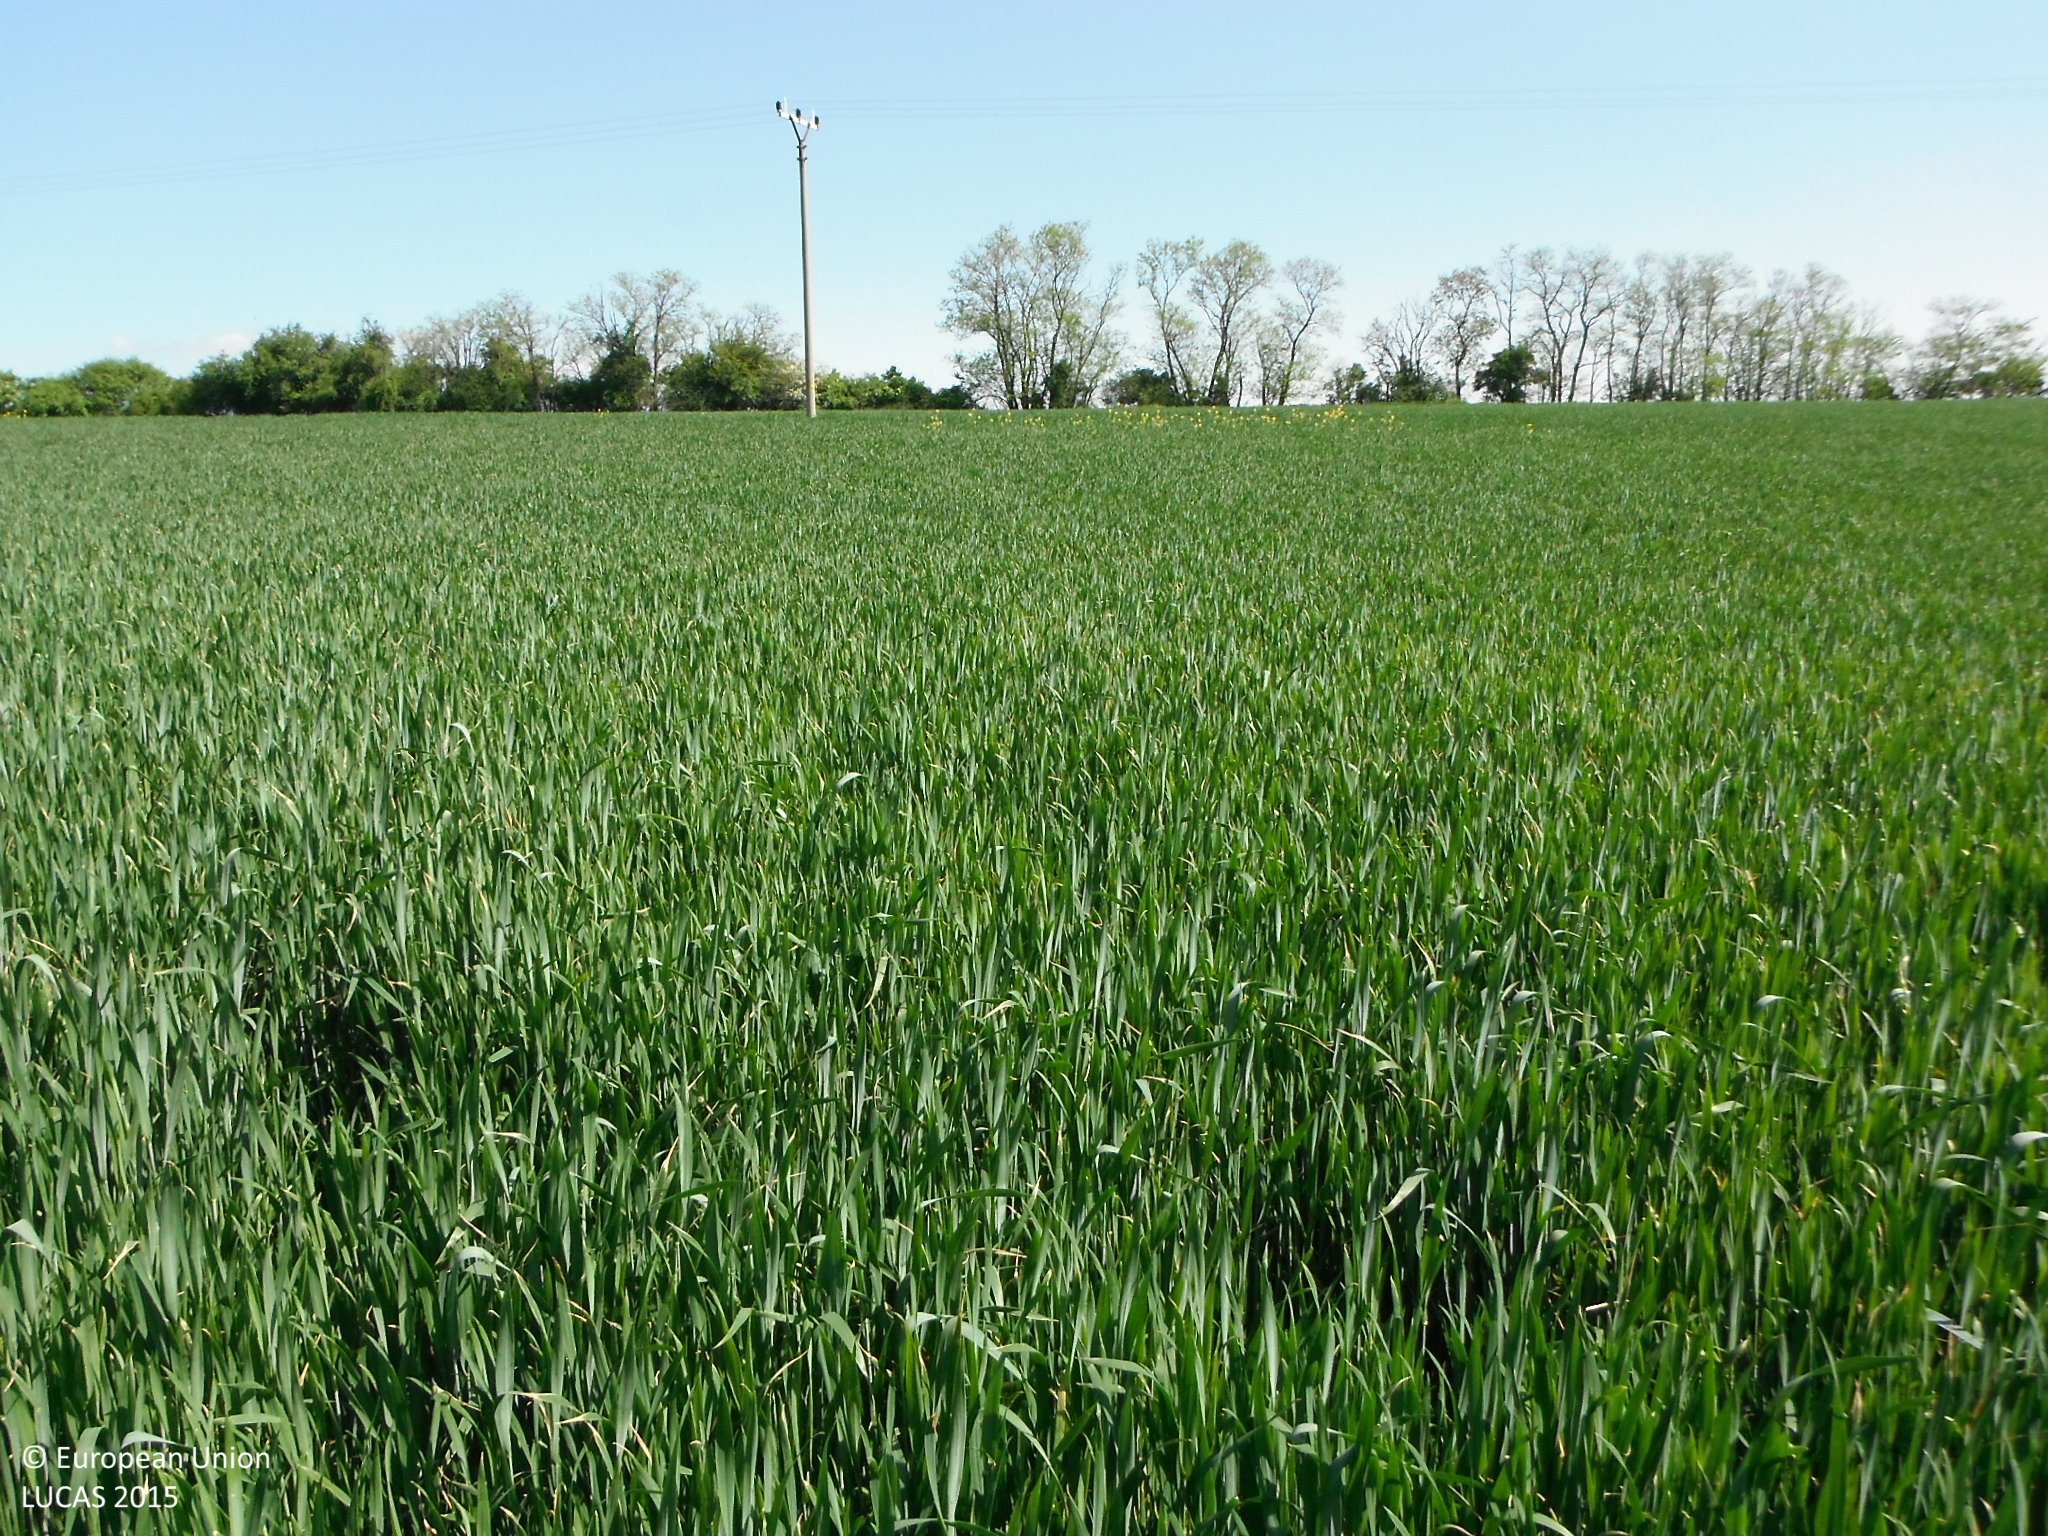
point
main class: Cropland
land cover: Common wheat
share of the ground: > 75 %
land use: Agriculture (excluding fallow land and kitchen gardens)
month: May
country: SK
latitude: 48.3295
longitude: 18.2563
